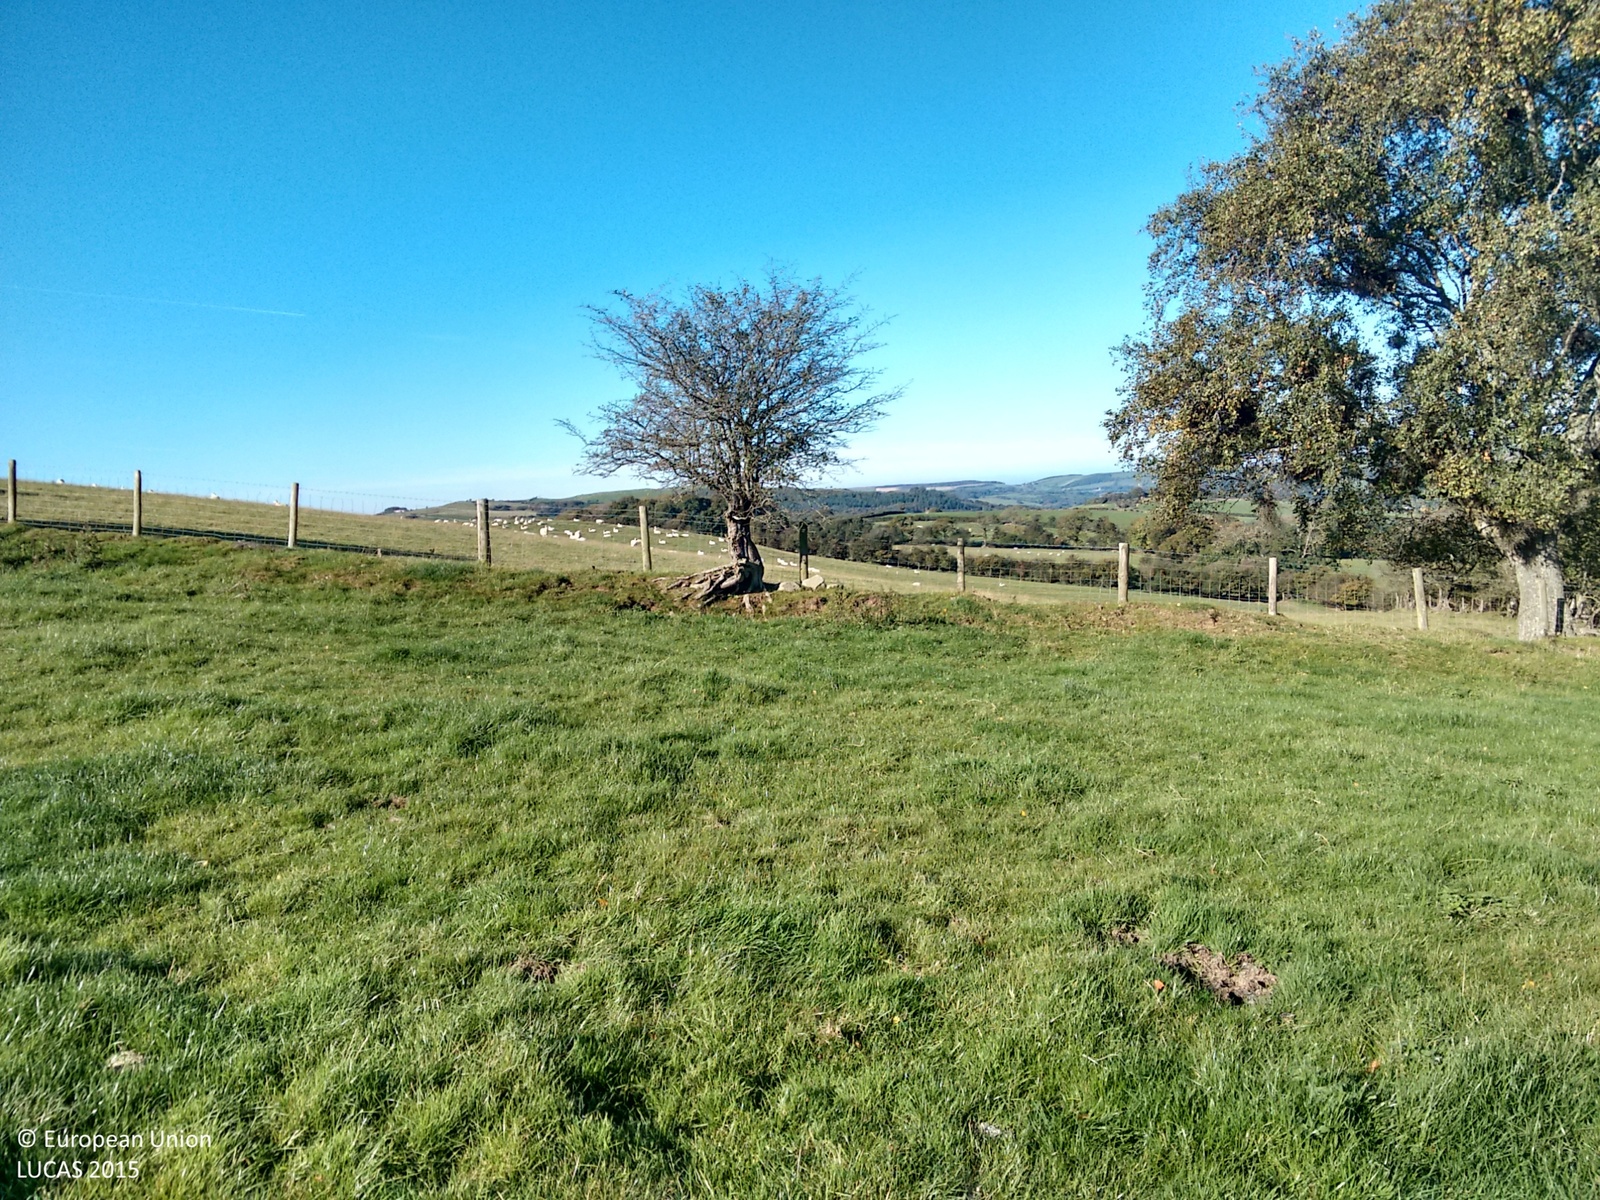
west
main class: Grassland
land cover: Grassland without tree/shrub cover
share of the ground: > 75 %
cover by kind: herbaceous plants 100 %
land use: Agriculture (excluding fallow land and kitchen gardens)
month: October
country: GB
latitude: 52.3462
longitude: -3.9960
